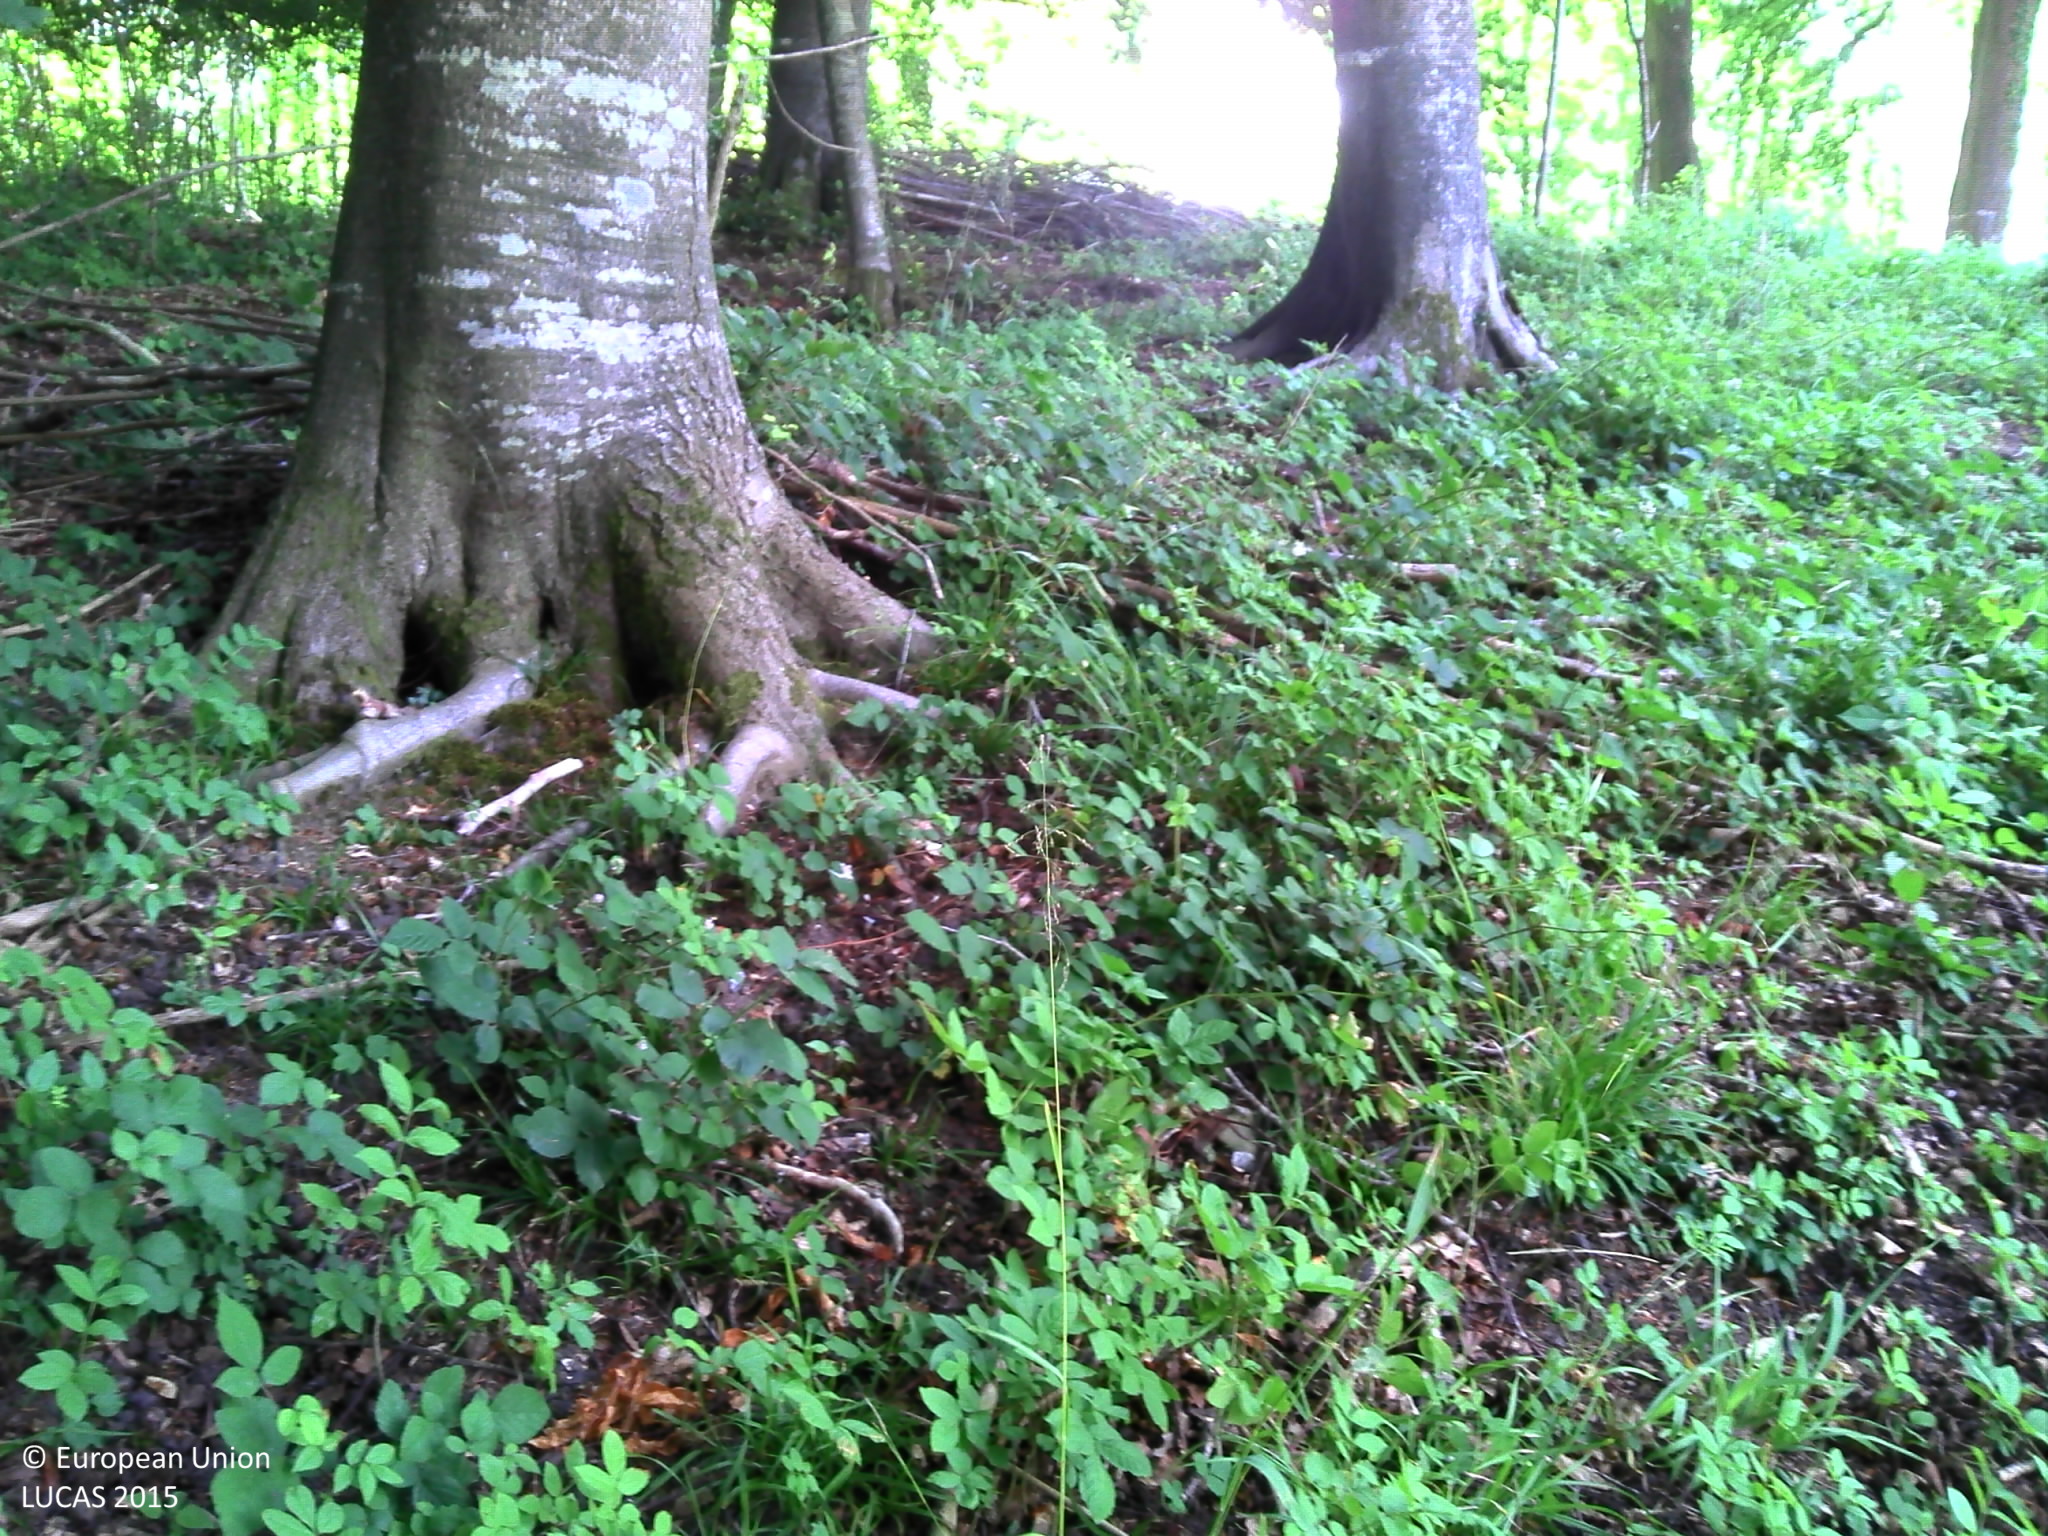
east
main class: Woodland
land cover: Broadleaved woodland
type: acidophilous oak and oak-birch forest
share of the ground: > 75 %
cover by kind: broadleaved forest trees 90 %, herbaceous plants 5 %, lichens and mosses 5 %
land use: Forestry
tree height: > 5 m
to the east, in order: Broadleaved woodland; Tracks; Broadleaved woodland
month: June
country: FR
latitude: 50.2018
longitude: 2.4075
